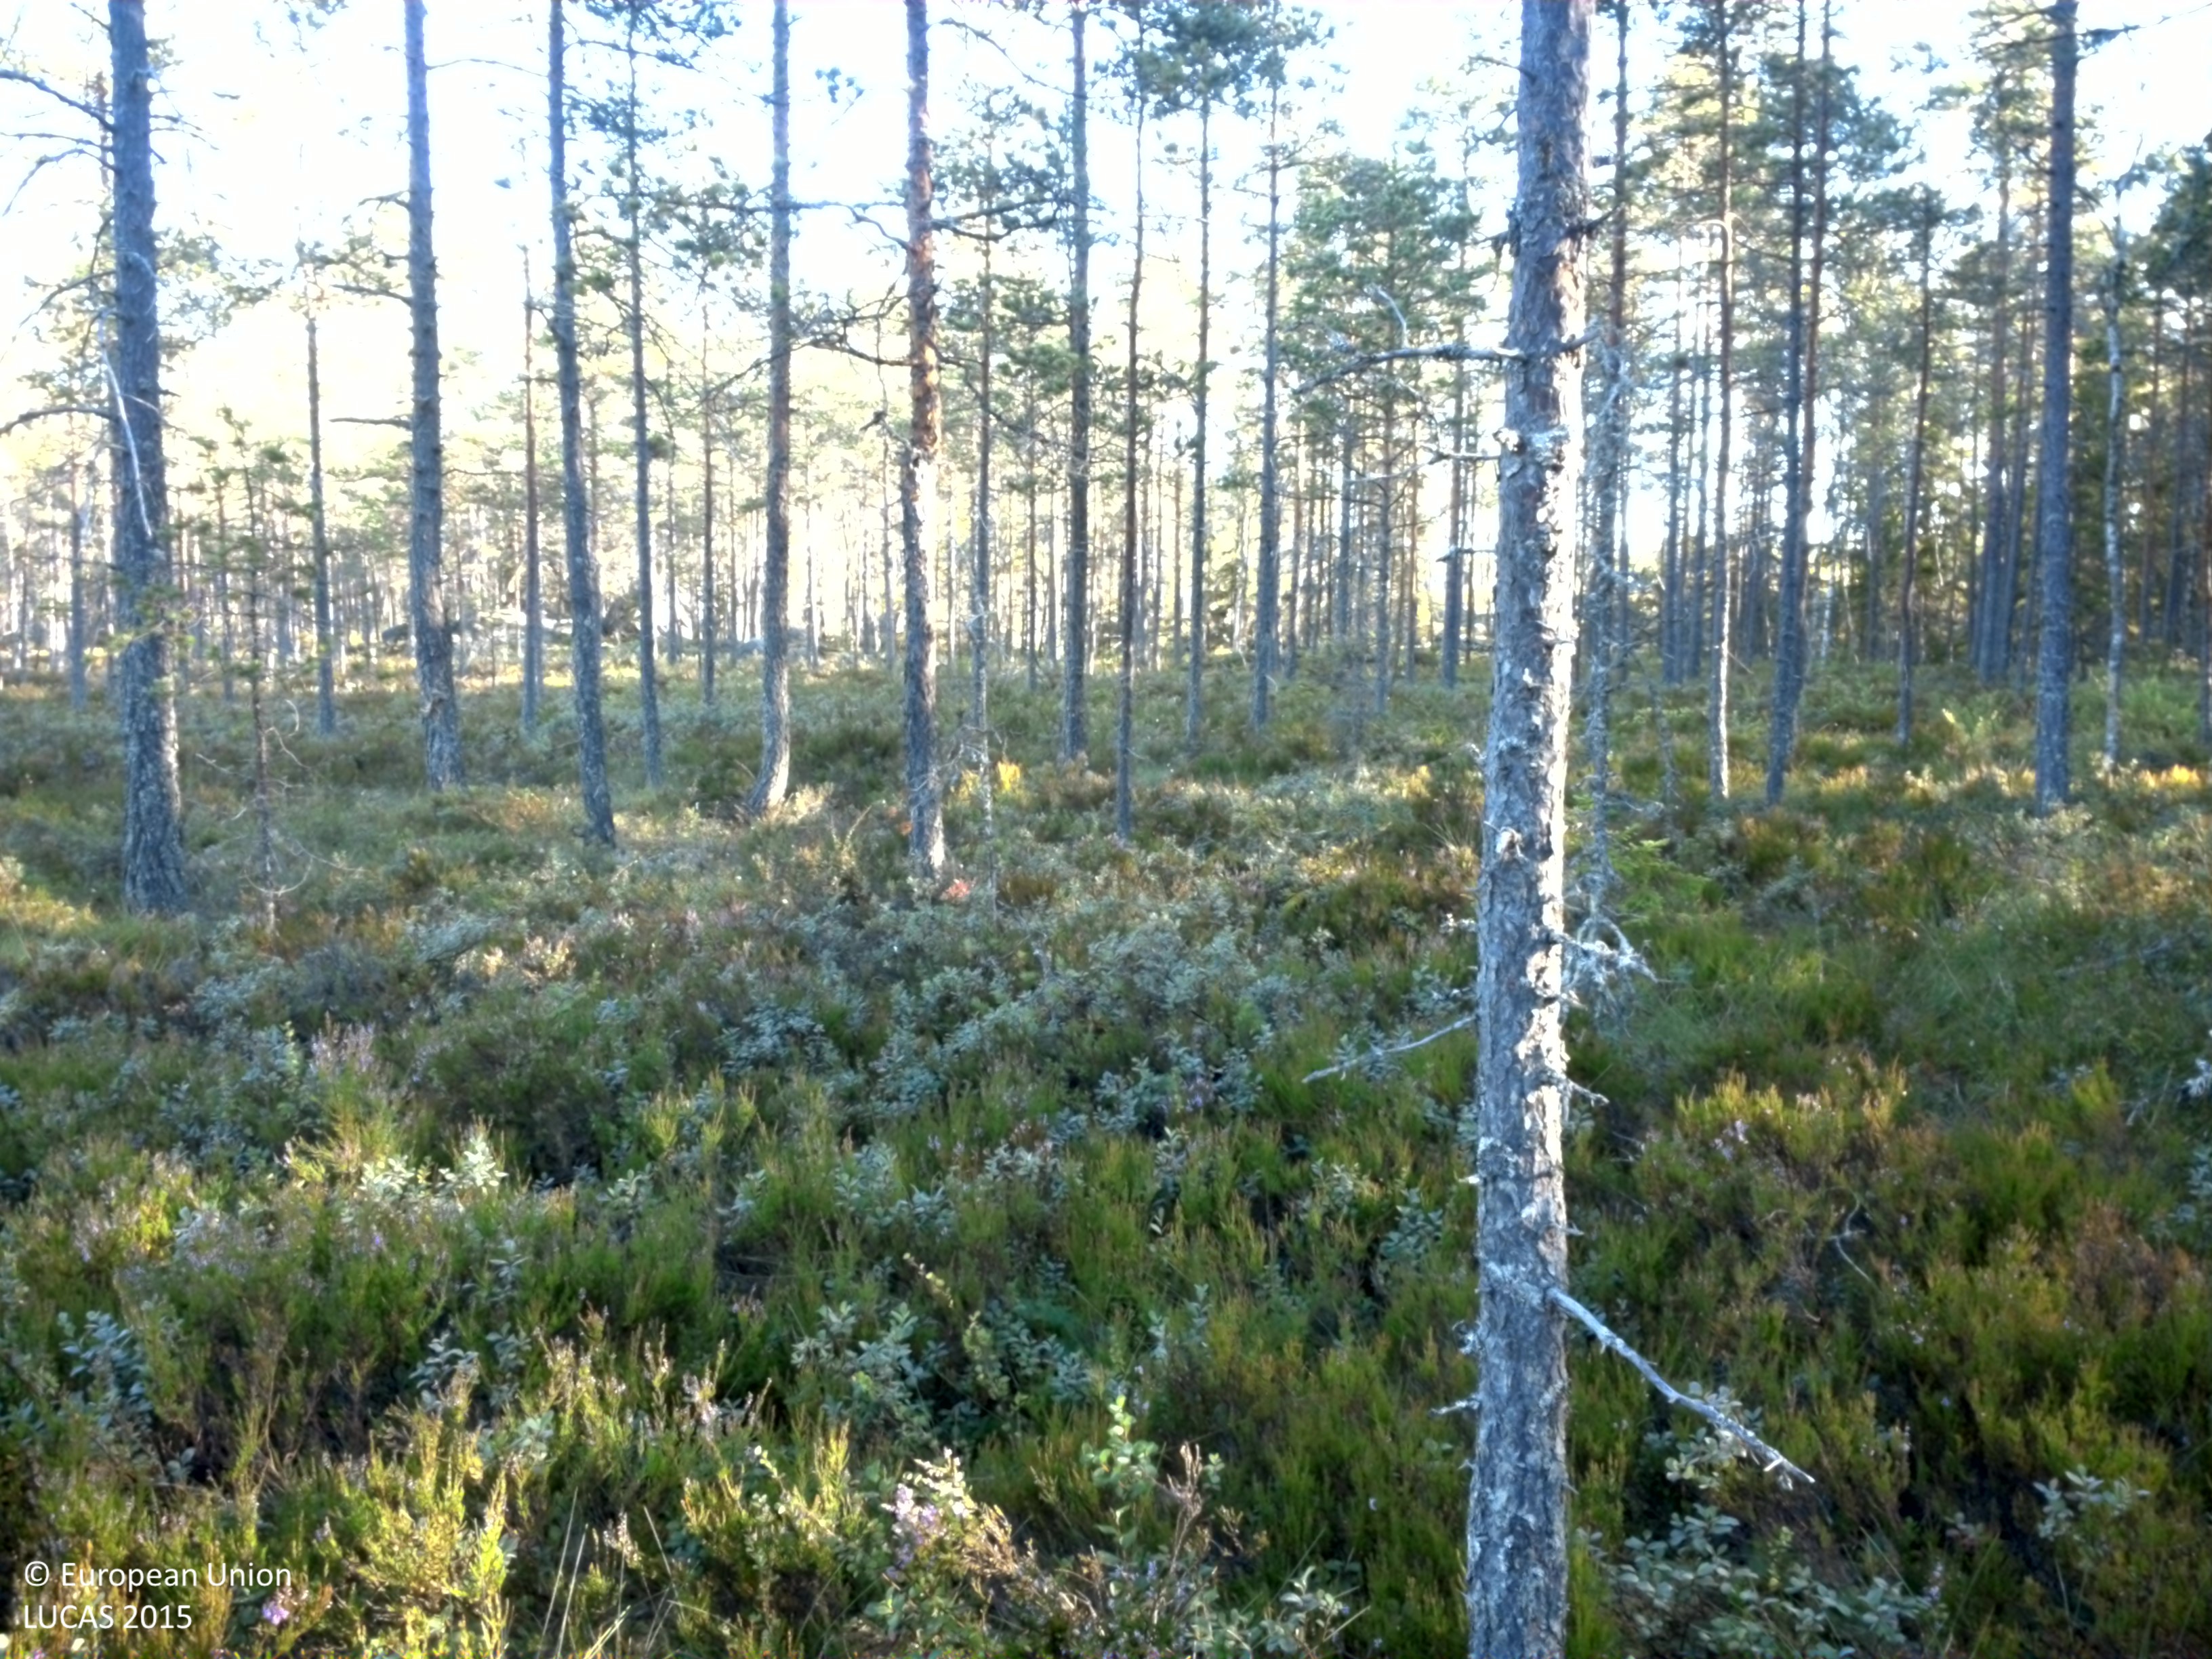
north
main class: Woodland
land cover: Pine dominated coniferous woodland
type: boreal forest
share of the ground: 25 - 50 %
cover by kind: coniferous forest trees 40 %, shrubs 40 %, lichens and mosses 20 %
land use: Semi-natural and natural areas not in use
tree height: > 5 m
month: August
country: SE
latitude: 59.9031
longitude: 14.1557
